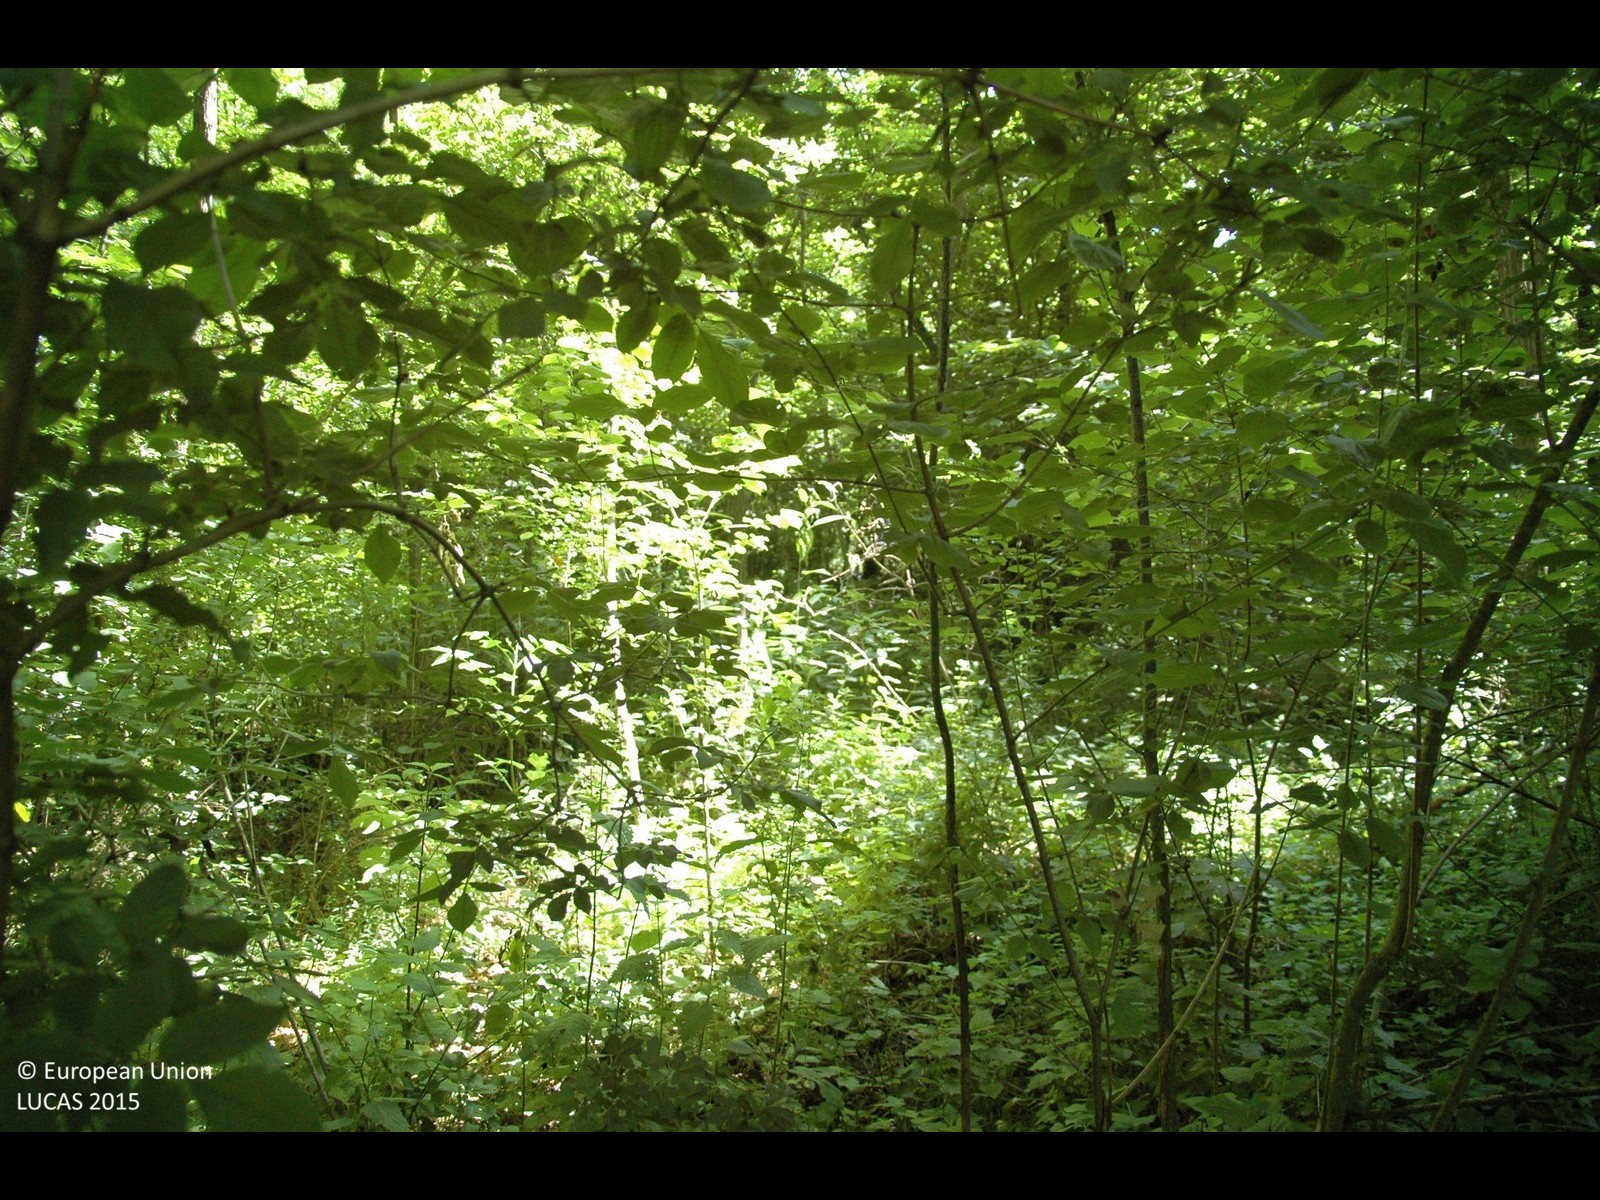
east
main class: Woodland
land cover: Broadleaved woodland
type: mesophytic deciduous forest
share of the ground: > 75 %
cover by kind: broadleaved forest trees 100 %
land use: Forestry
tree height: > 5 m
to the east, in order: Broadleaved woodland; Maize; Broadleaved woodland; Spontaneously vegetated surfaces; Broadleaved woodland; Ditches and canals; Broadleaved woodland; Maize; Spontaneously vegetated surfaces; Maize; Grassland without tree/shrub cover
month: June
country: HR
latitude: 46.4136
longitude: 16.6754
